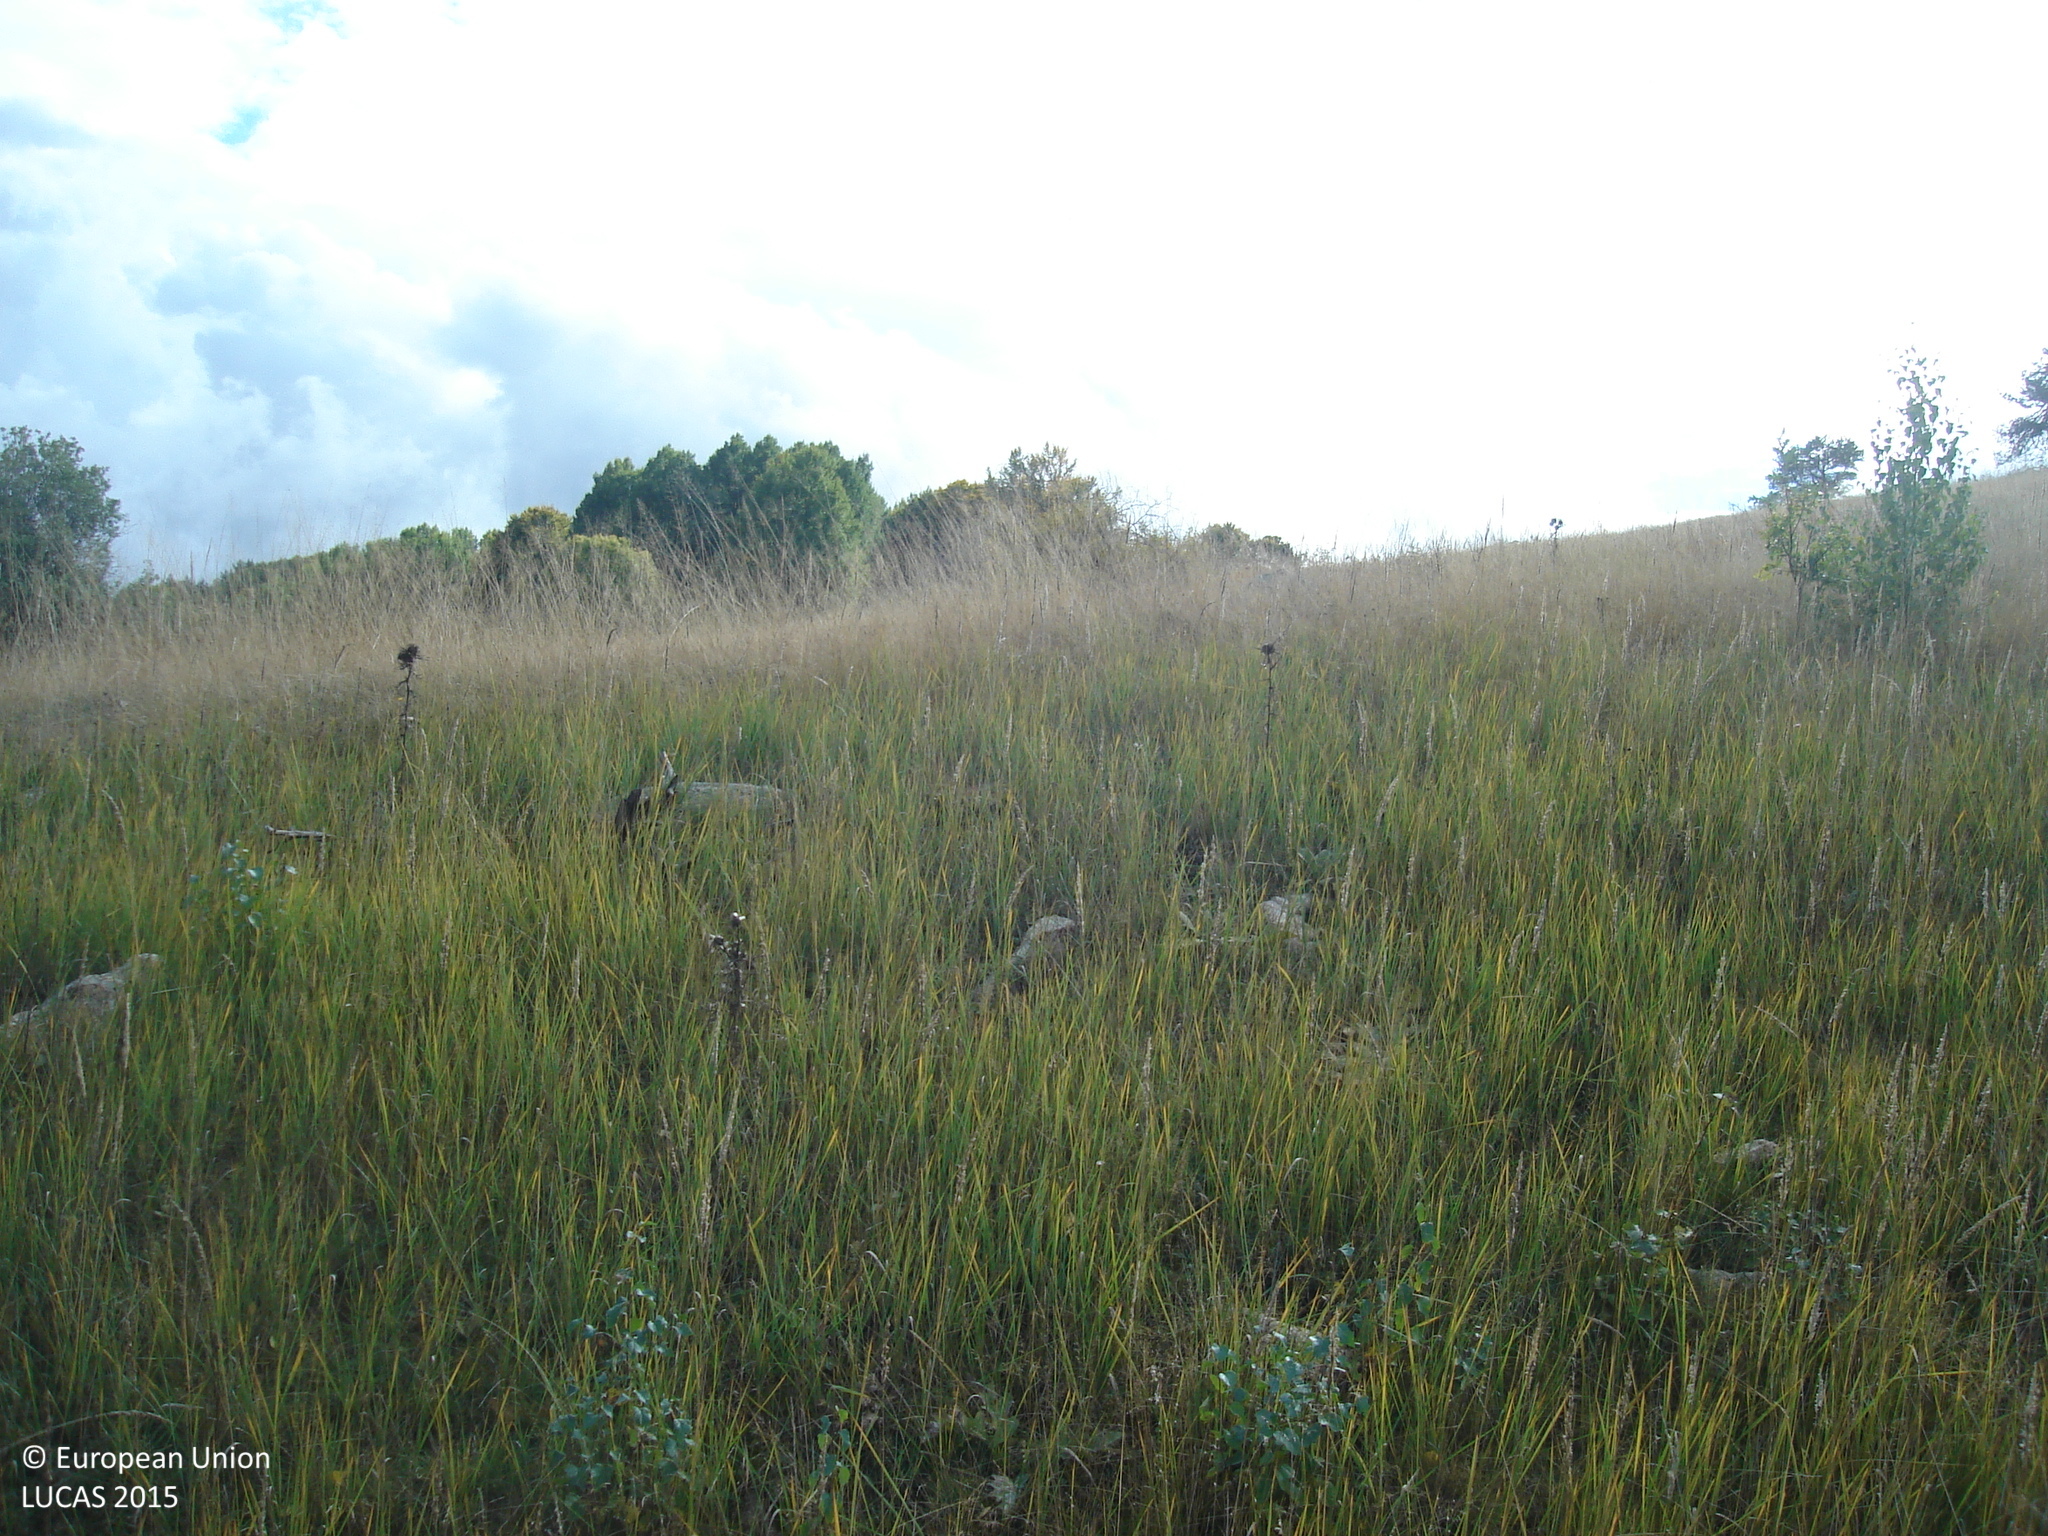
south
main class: Grassland
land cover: Grassland with sparse tree/shrub cover
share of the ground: > 75 %
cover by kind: herbaceous plants 95 %, broadleaved forest trees 5 %
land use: Agriculture (excluding fallow land and kitchen gardens)
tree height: > 5 m
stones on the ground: < 10 %
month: October
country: BG
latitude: 42.5905
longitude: 24.3932
